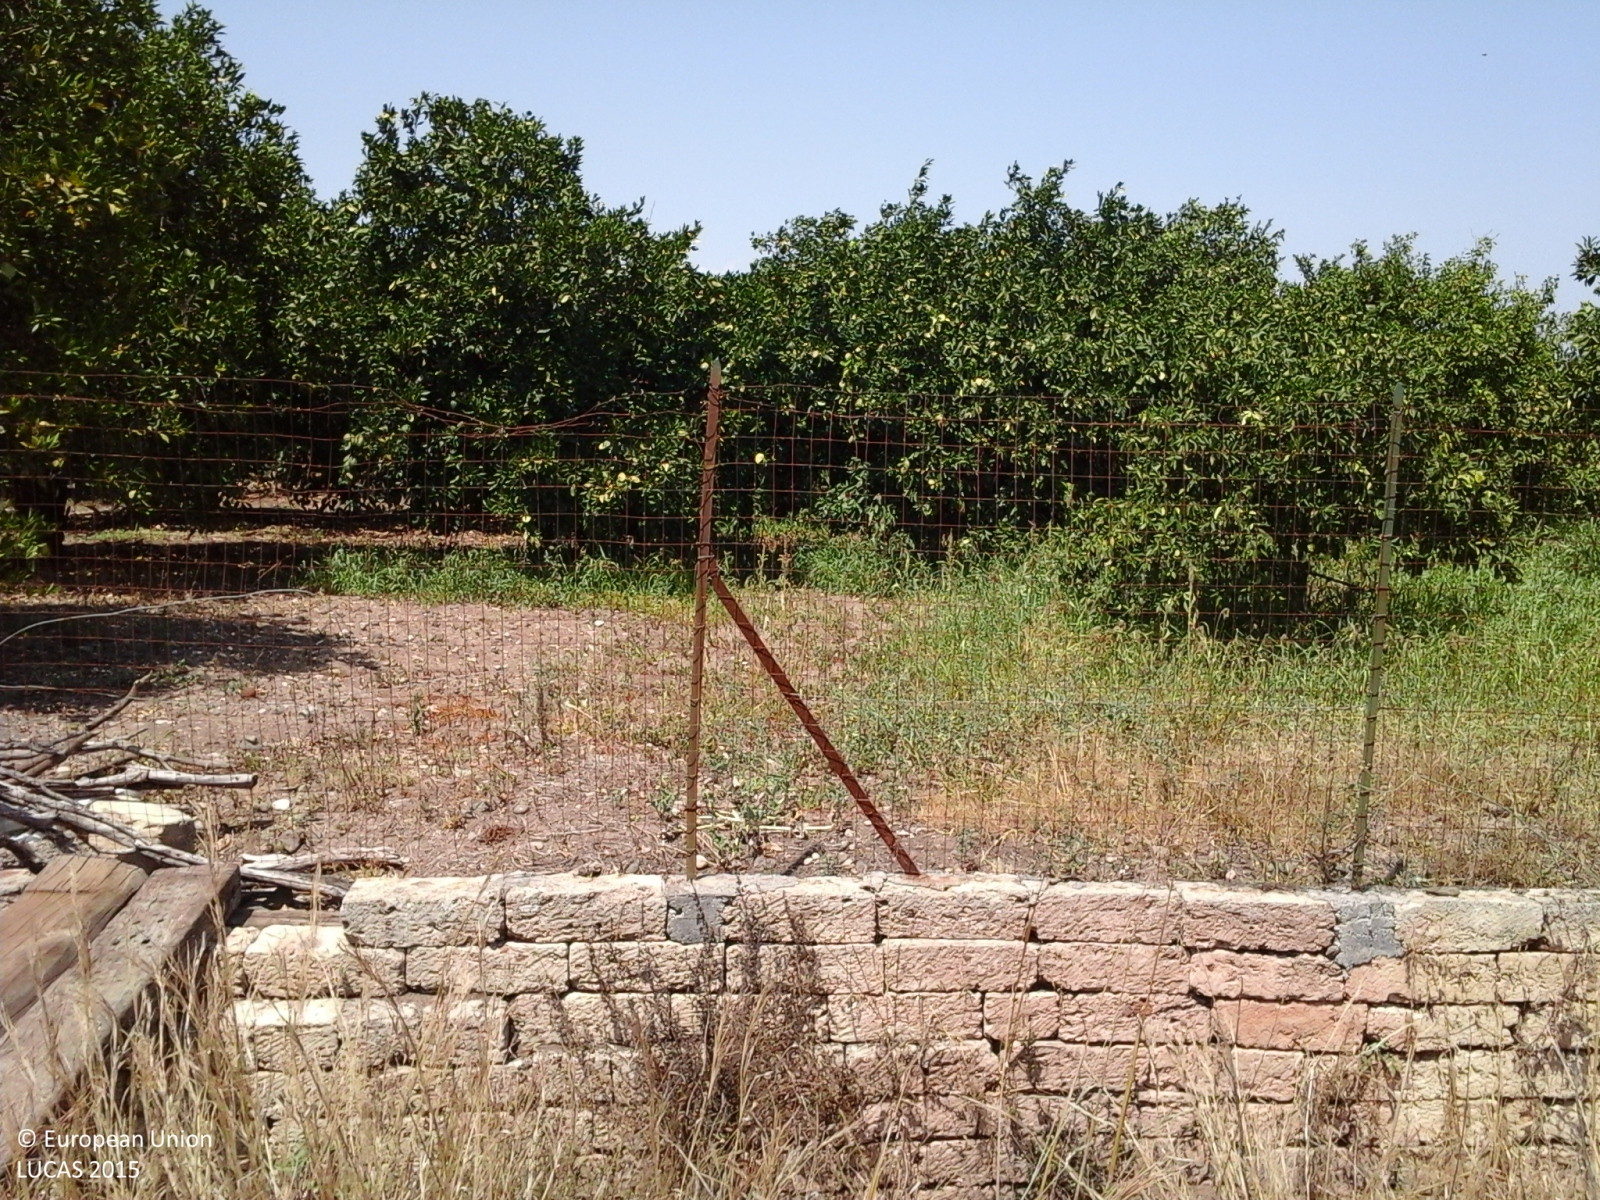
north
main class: Cropland
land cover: Oranges
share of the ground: > 75 %
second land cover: Spontaneously vegetated surfaces
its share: > 75 %
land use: Agriculture (excluding fallow land and kitchen gardens)
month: August
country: IT
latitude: 37.3123
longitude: 14.8944
